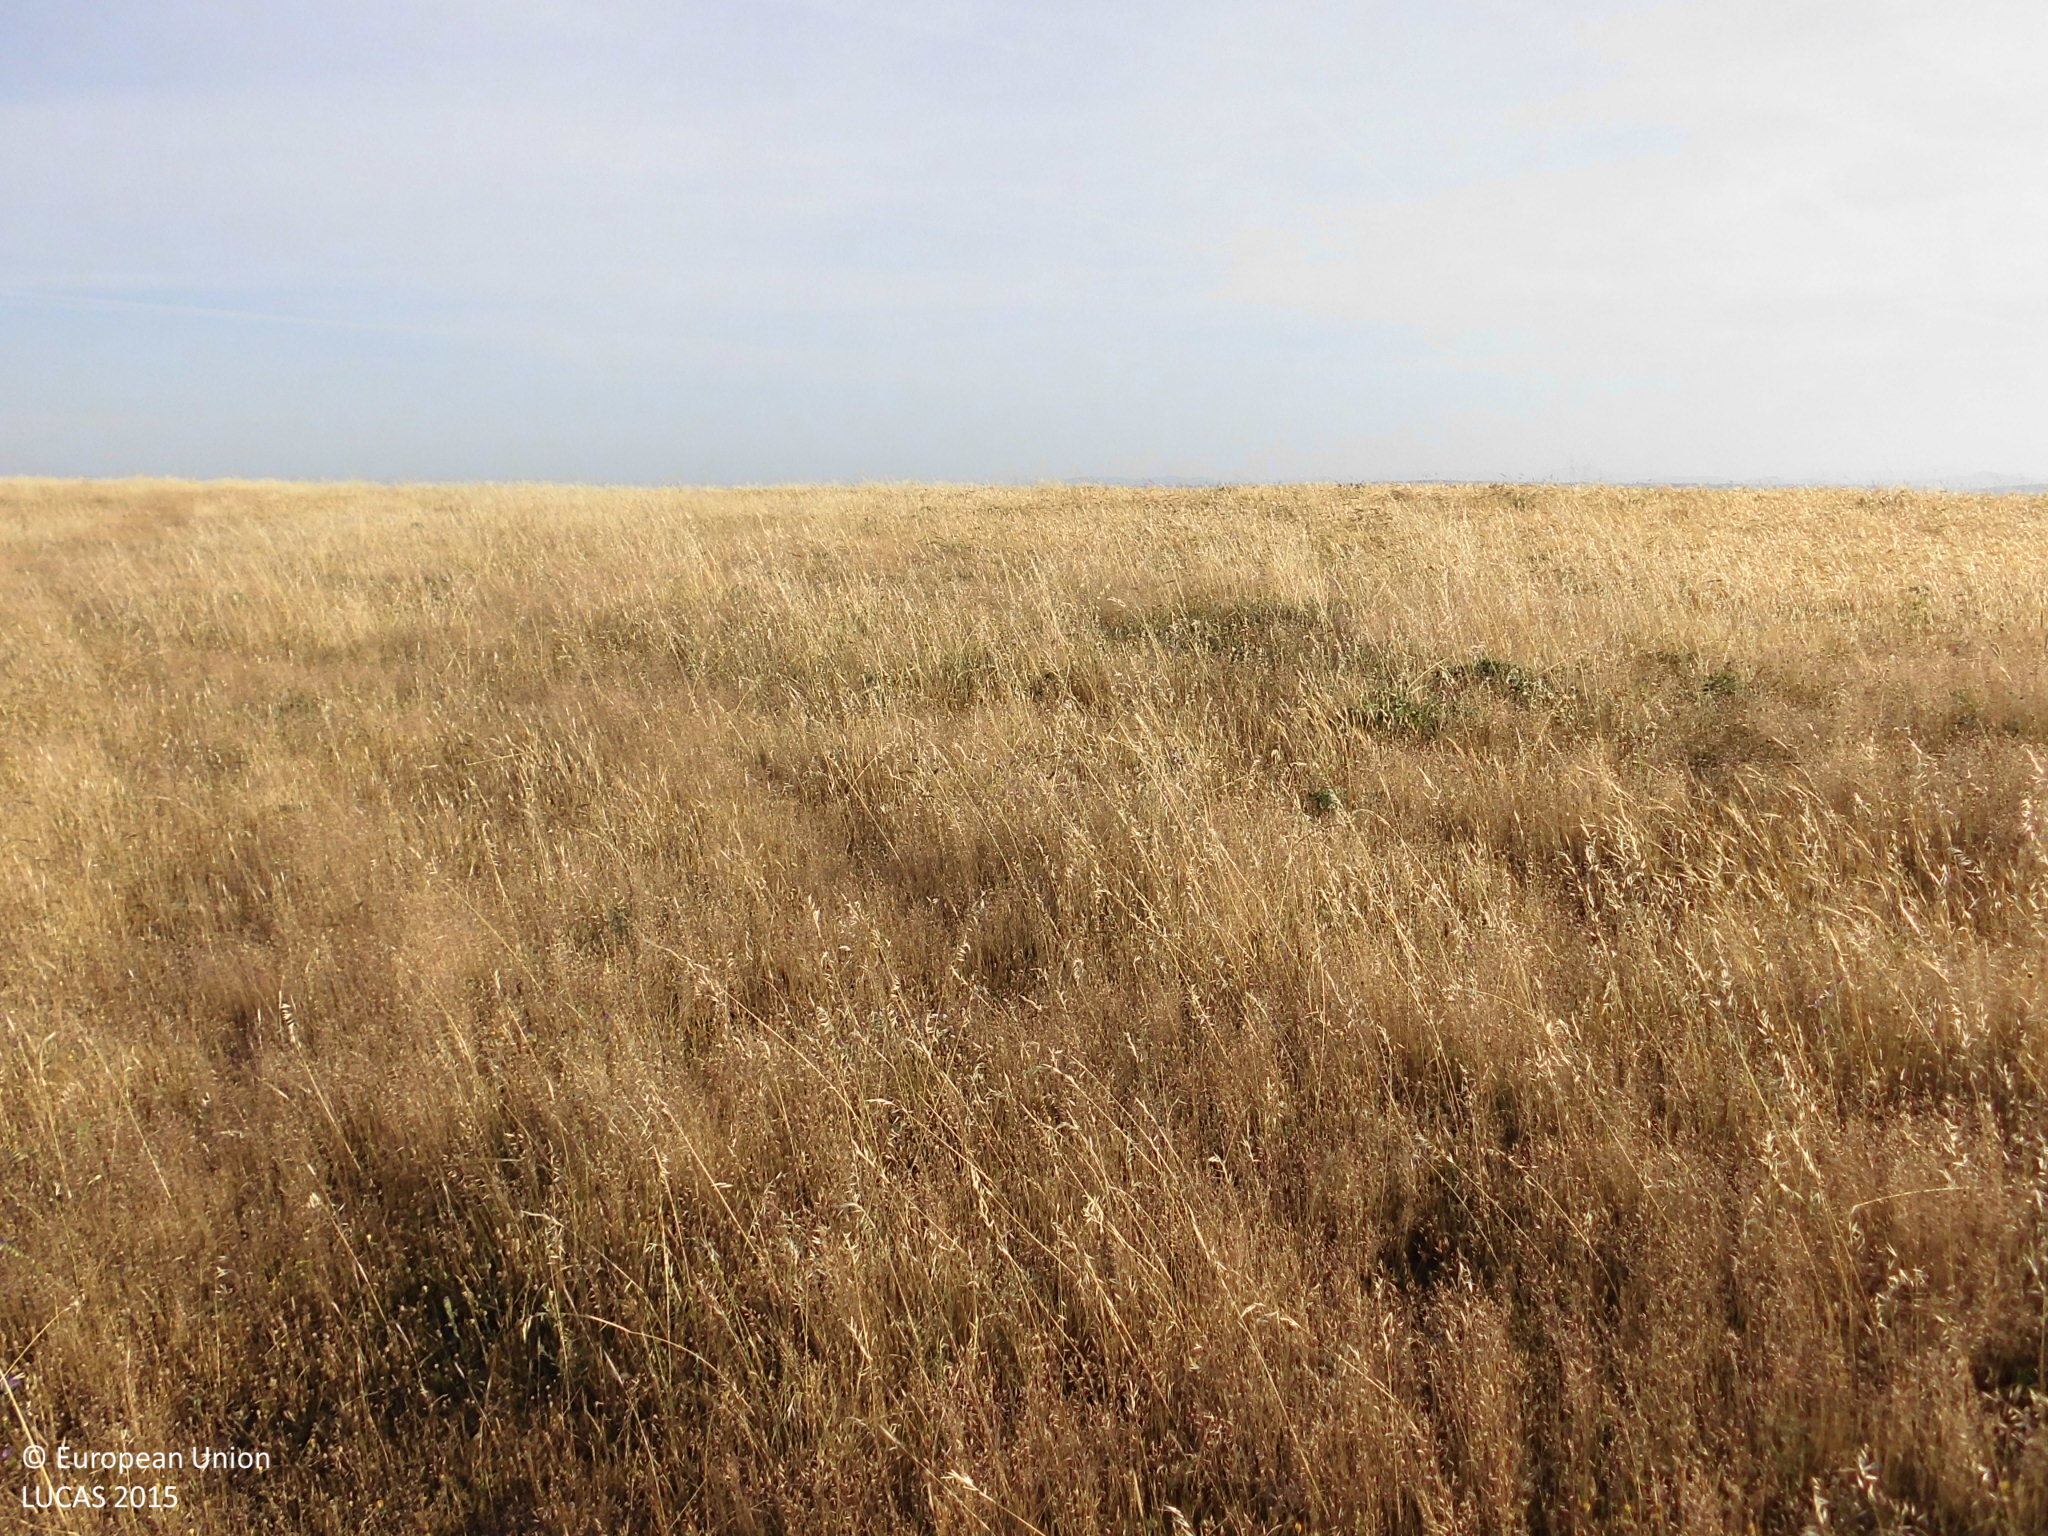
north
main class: Grassland
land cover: Grassland without tree/shrub cover
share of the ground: > 75 %
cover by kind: herbaceous plants 100 %
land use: Agriculture (excluding fallow land and kitchen gardens)
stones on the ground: 10 - 25 %
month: May
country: ES
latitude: 39.6301
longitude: -6.9413
